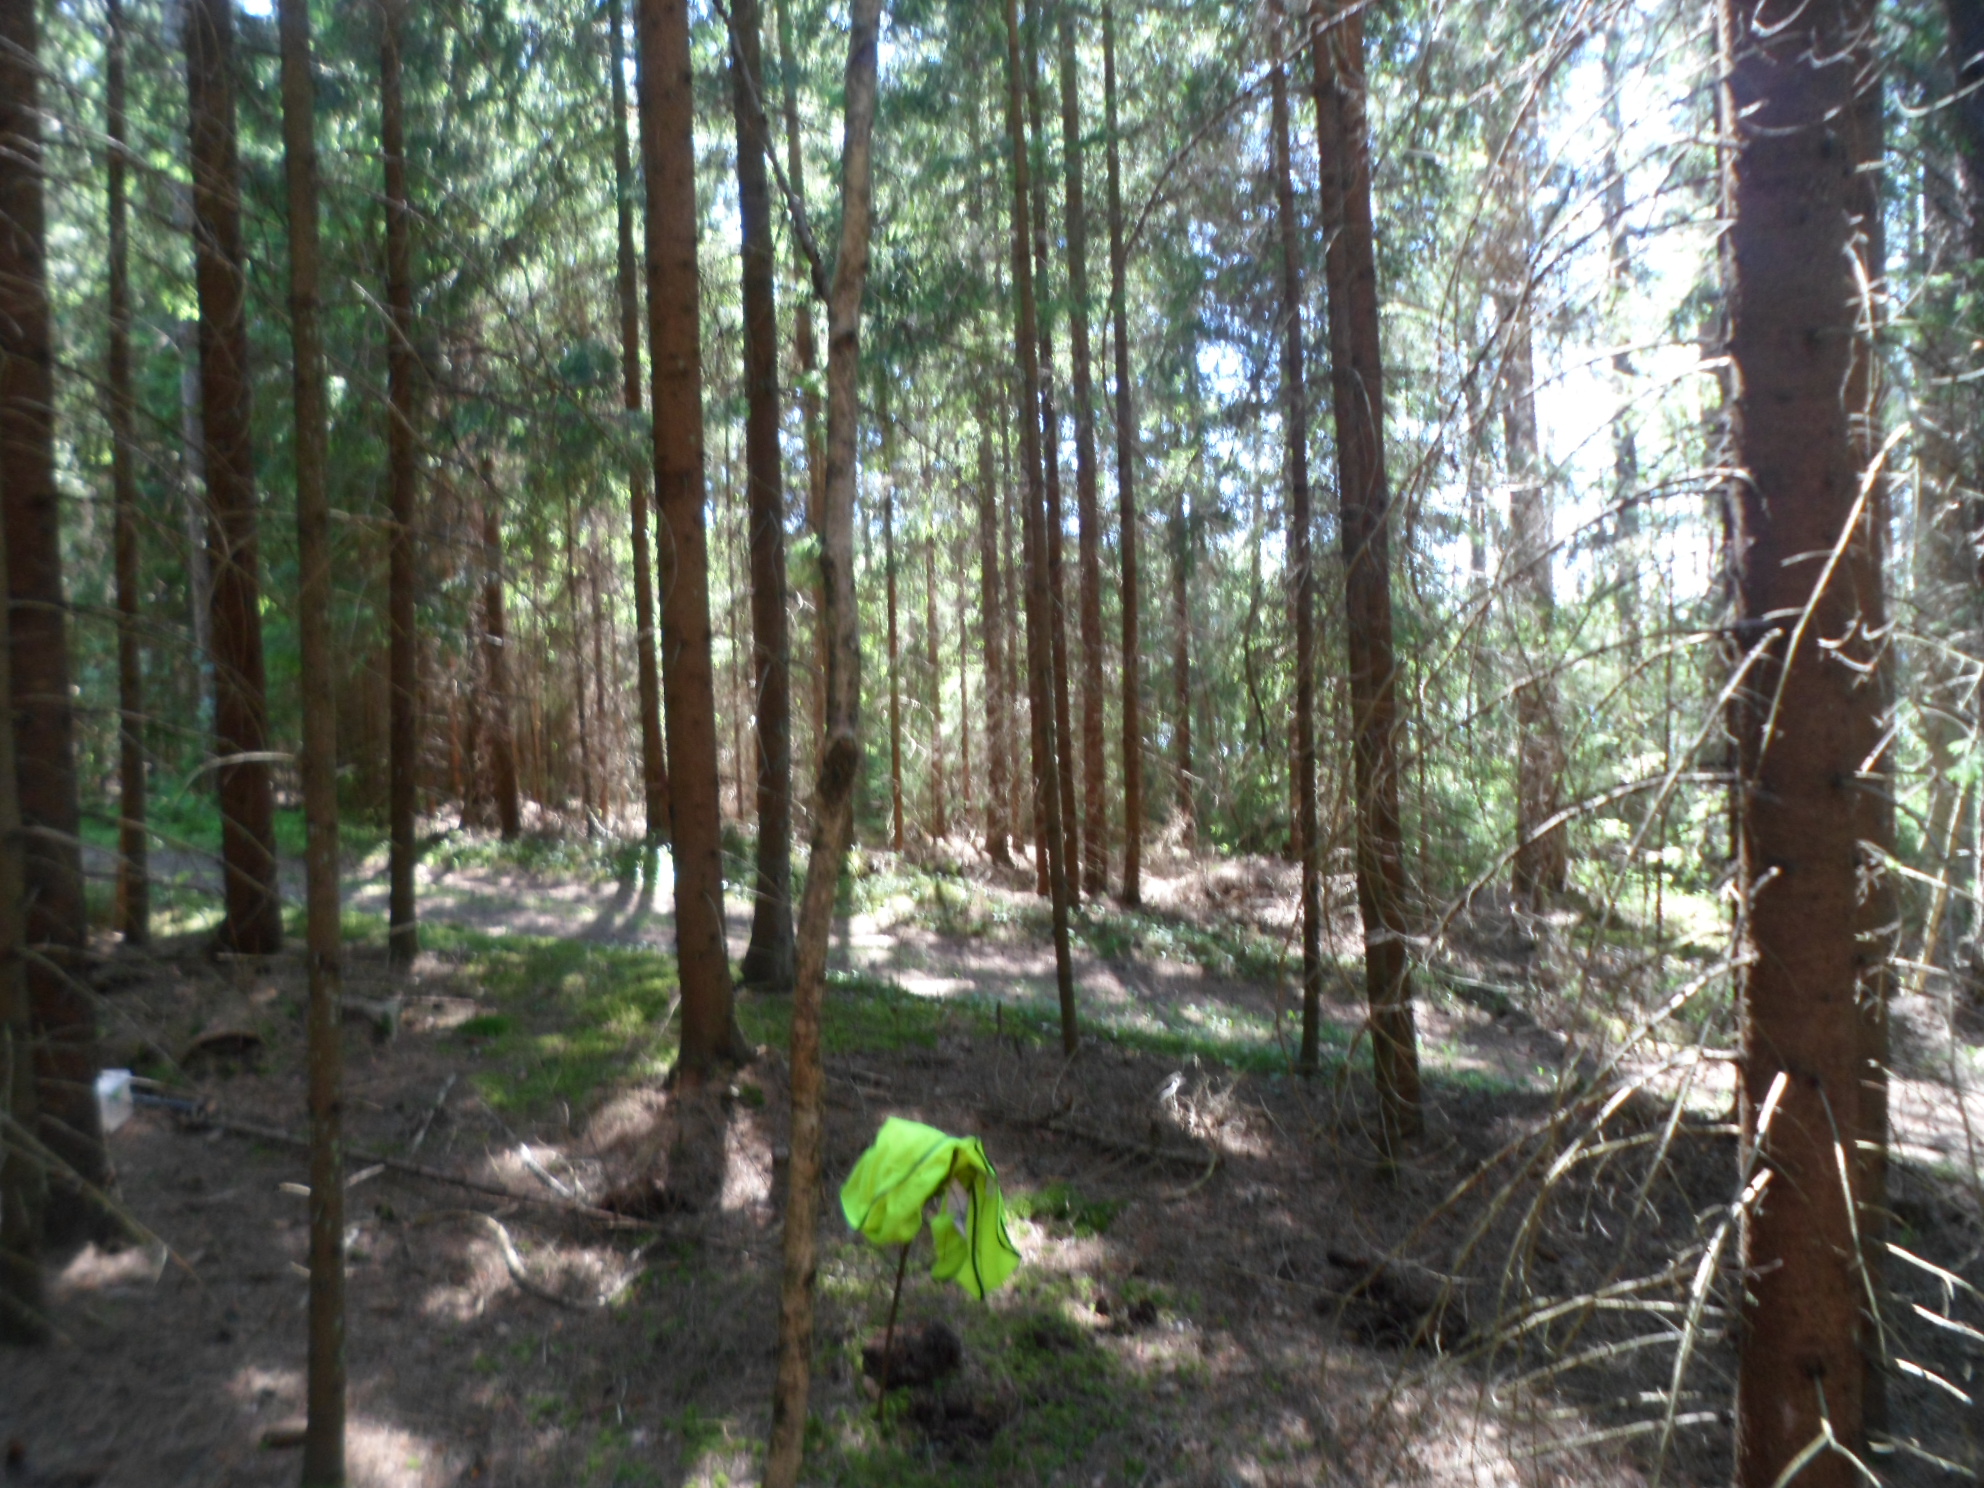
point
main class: Woodland
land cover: Spruce dominated coniferous woodland
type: boreal forest
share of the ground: 50 - 75 %
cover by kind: coniferous forest trees 65 %, lichens and mosses 15 %, unconsolidated bare surface 15 %, herbaceous plants 5 %
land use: Forestry
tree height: > 5 m
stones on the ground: < 10 %
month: July
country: SE
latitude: 57.1879
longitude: 14.5465
